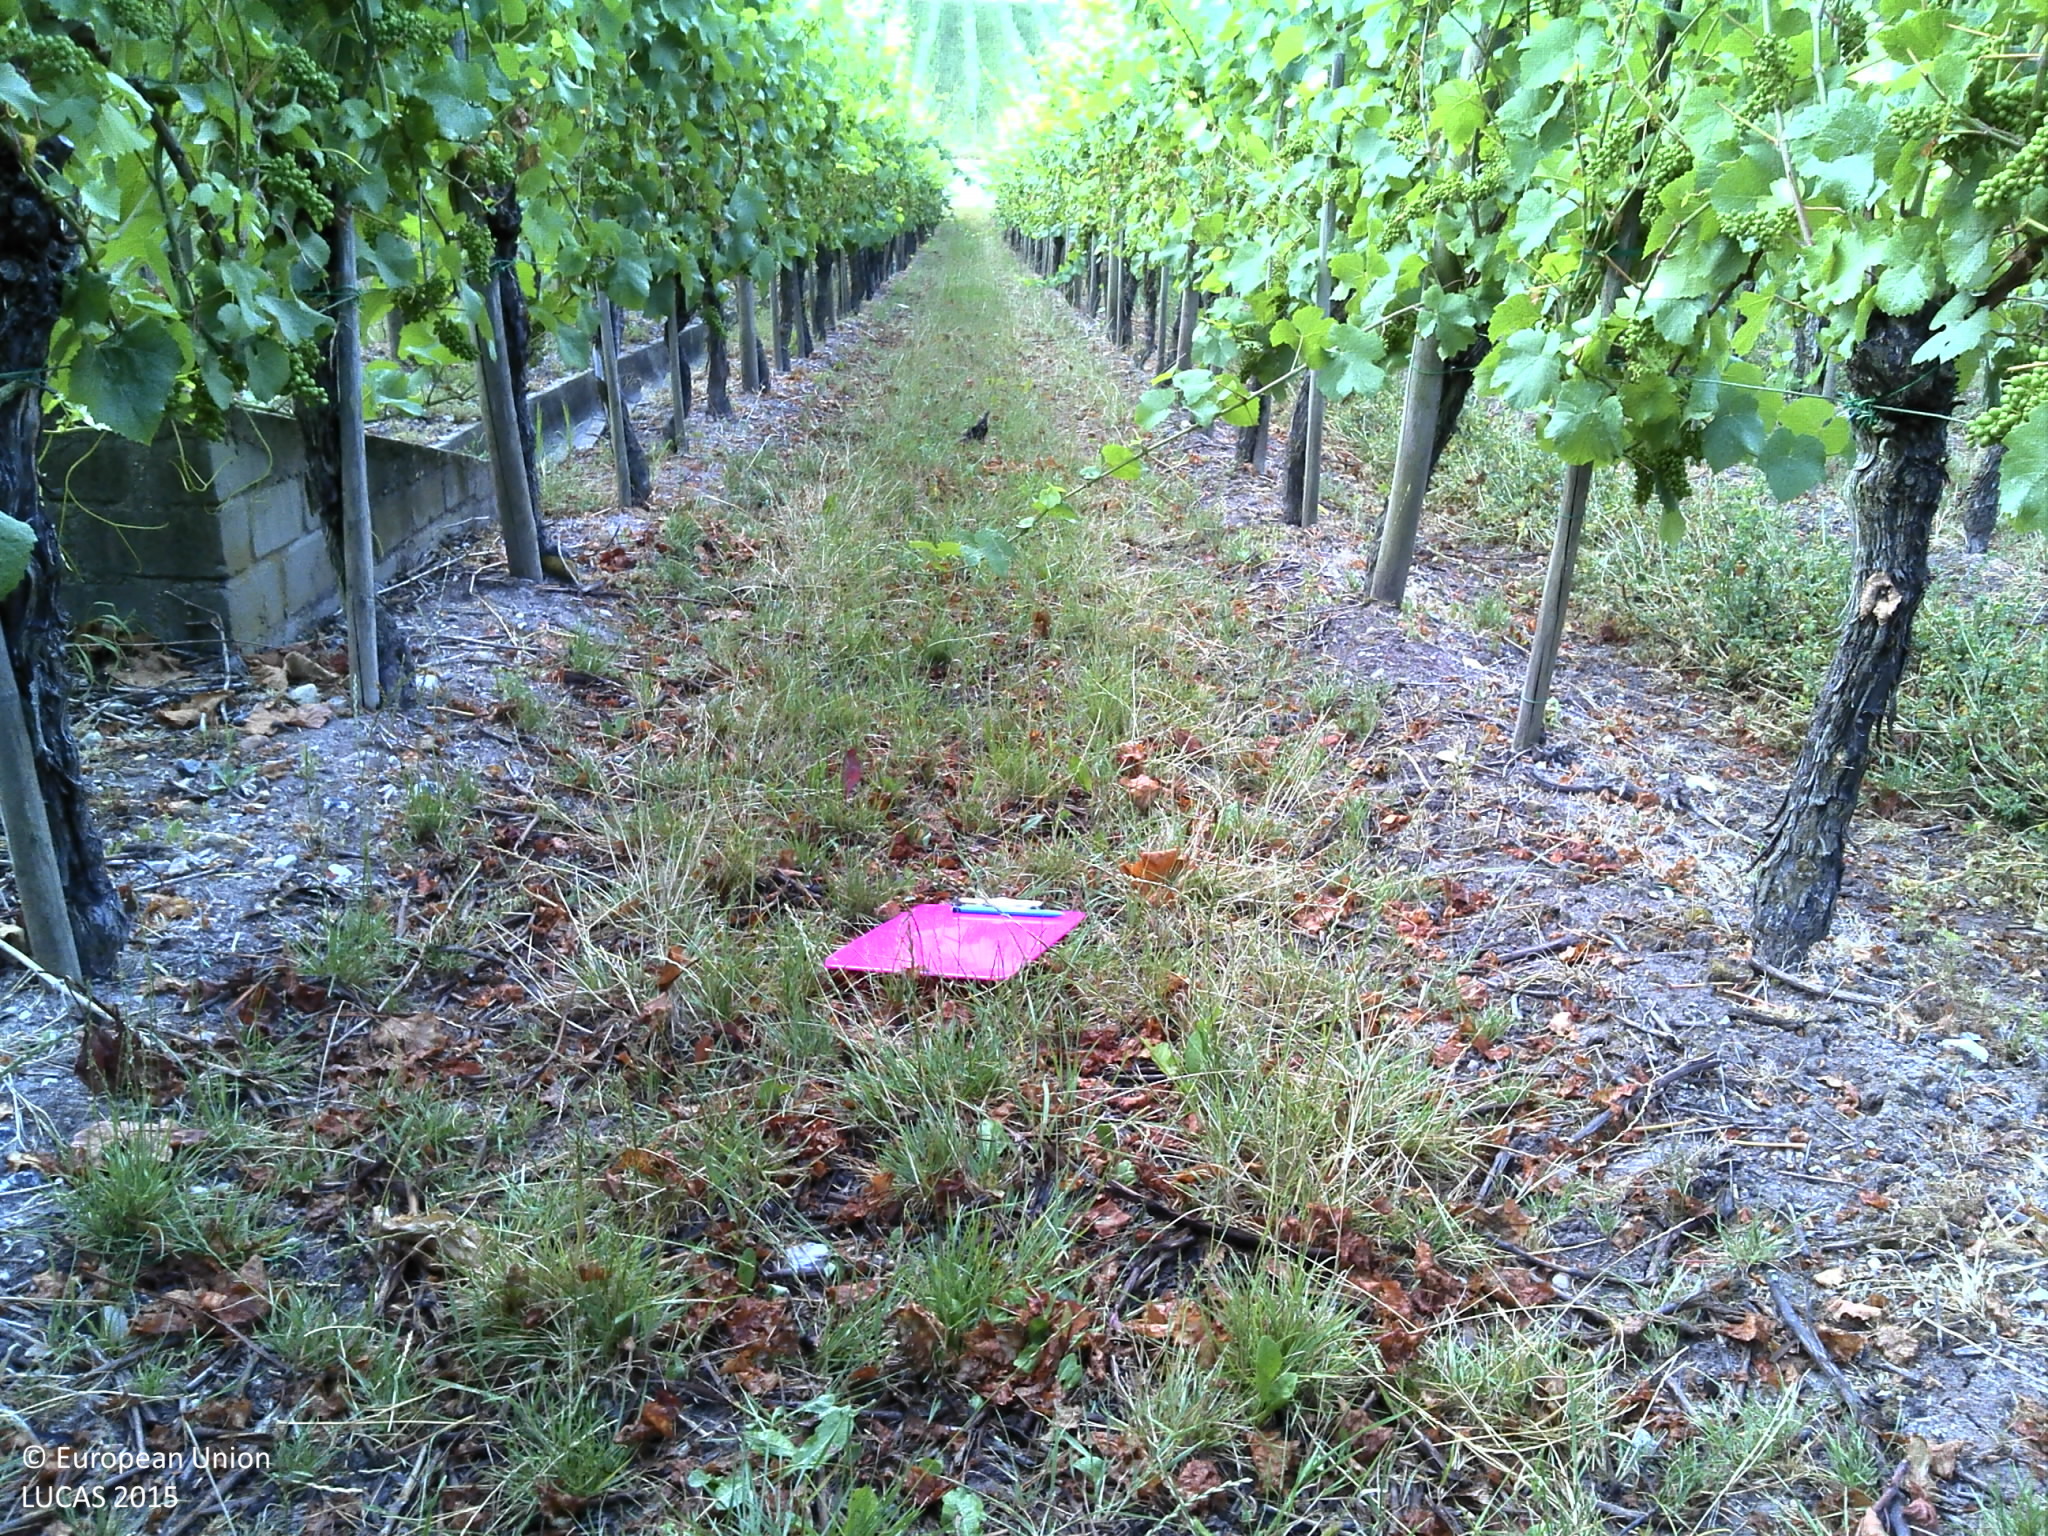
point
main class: Cropland
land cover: Vineyards
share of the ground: 50 - 75 %
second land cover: Grassland without tree/shrub cover
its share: 50 - 75 %
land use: Agriculture (excluding fallow land and kitchen gardens)
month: July
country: LU
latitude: 49.5314
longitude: 6.3382
